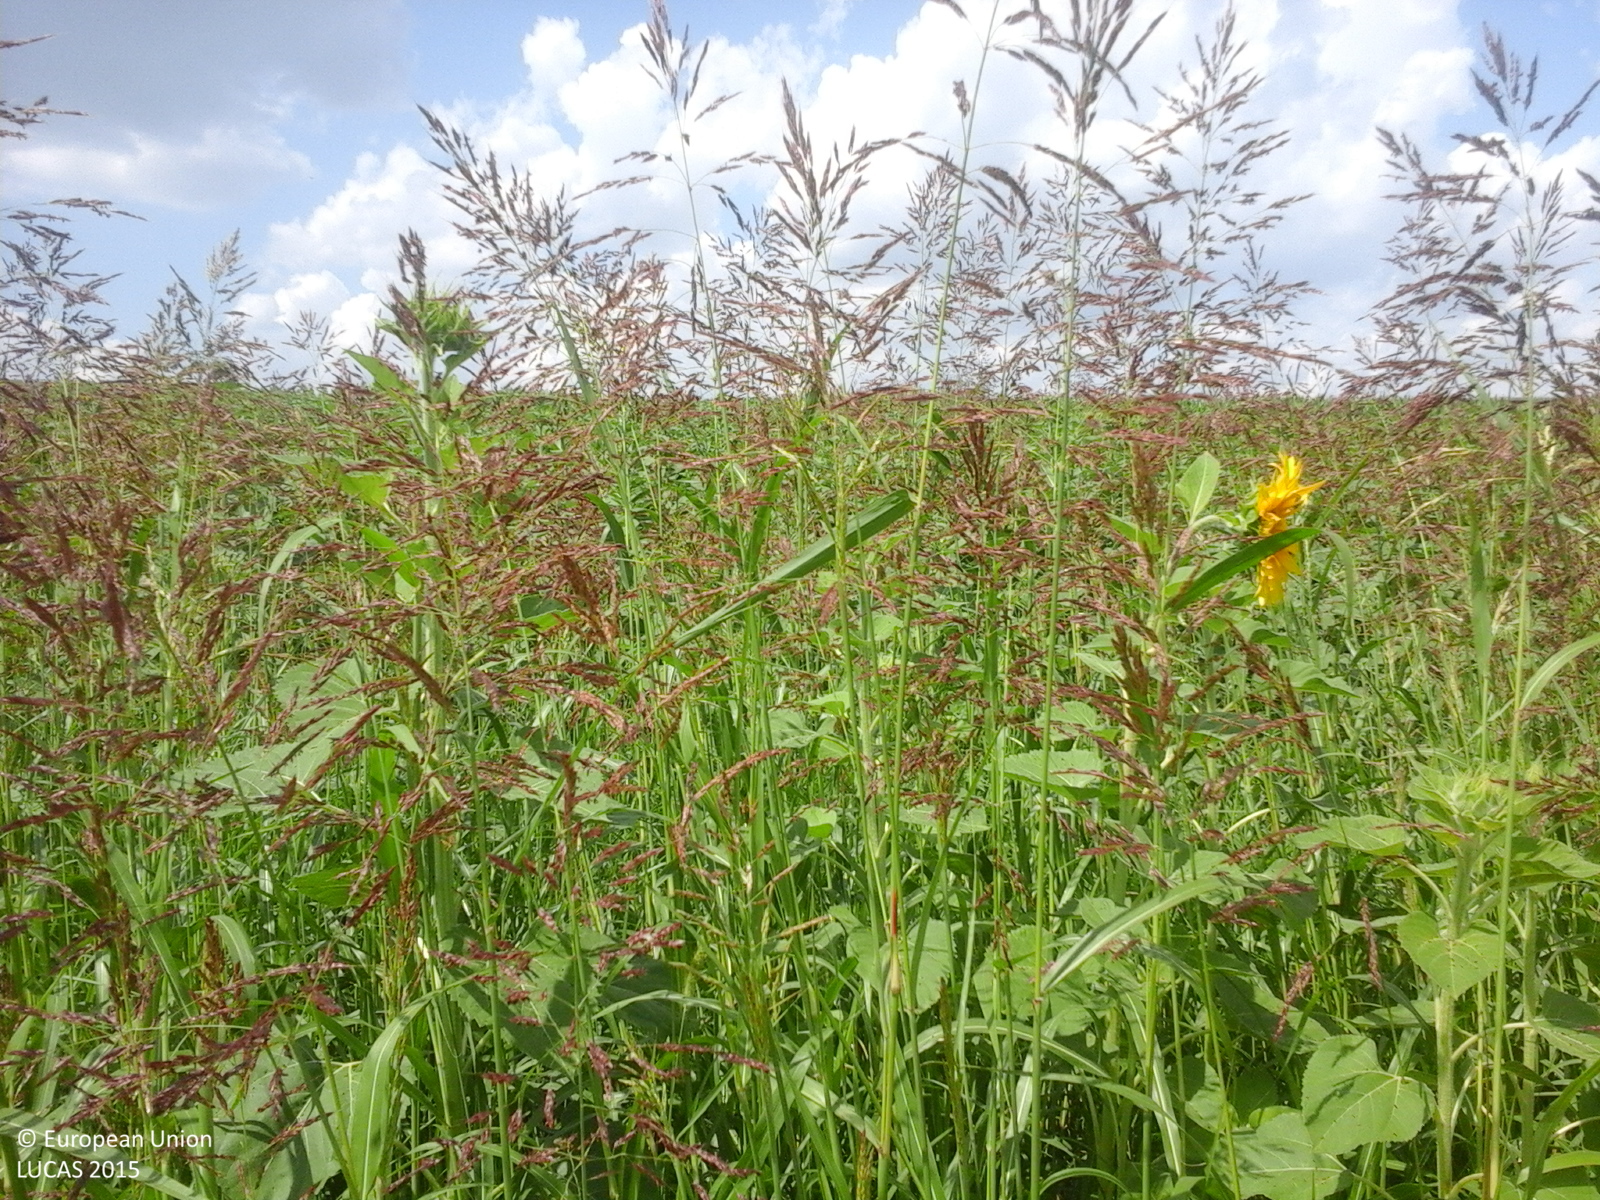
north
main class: Cropland
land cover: Sunflower
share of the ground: > 75 %
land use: Agriculture (excluding fallow land and kitchen gardens)
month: July
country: RO
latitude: 43.8576
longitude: 25.7289
